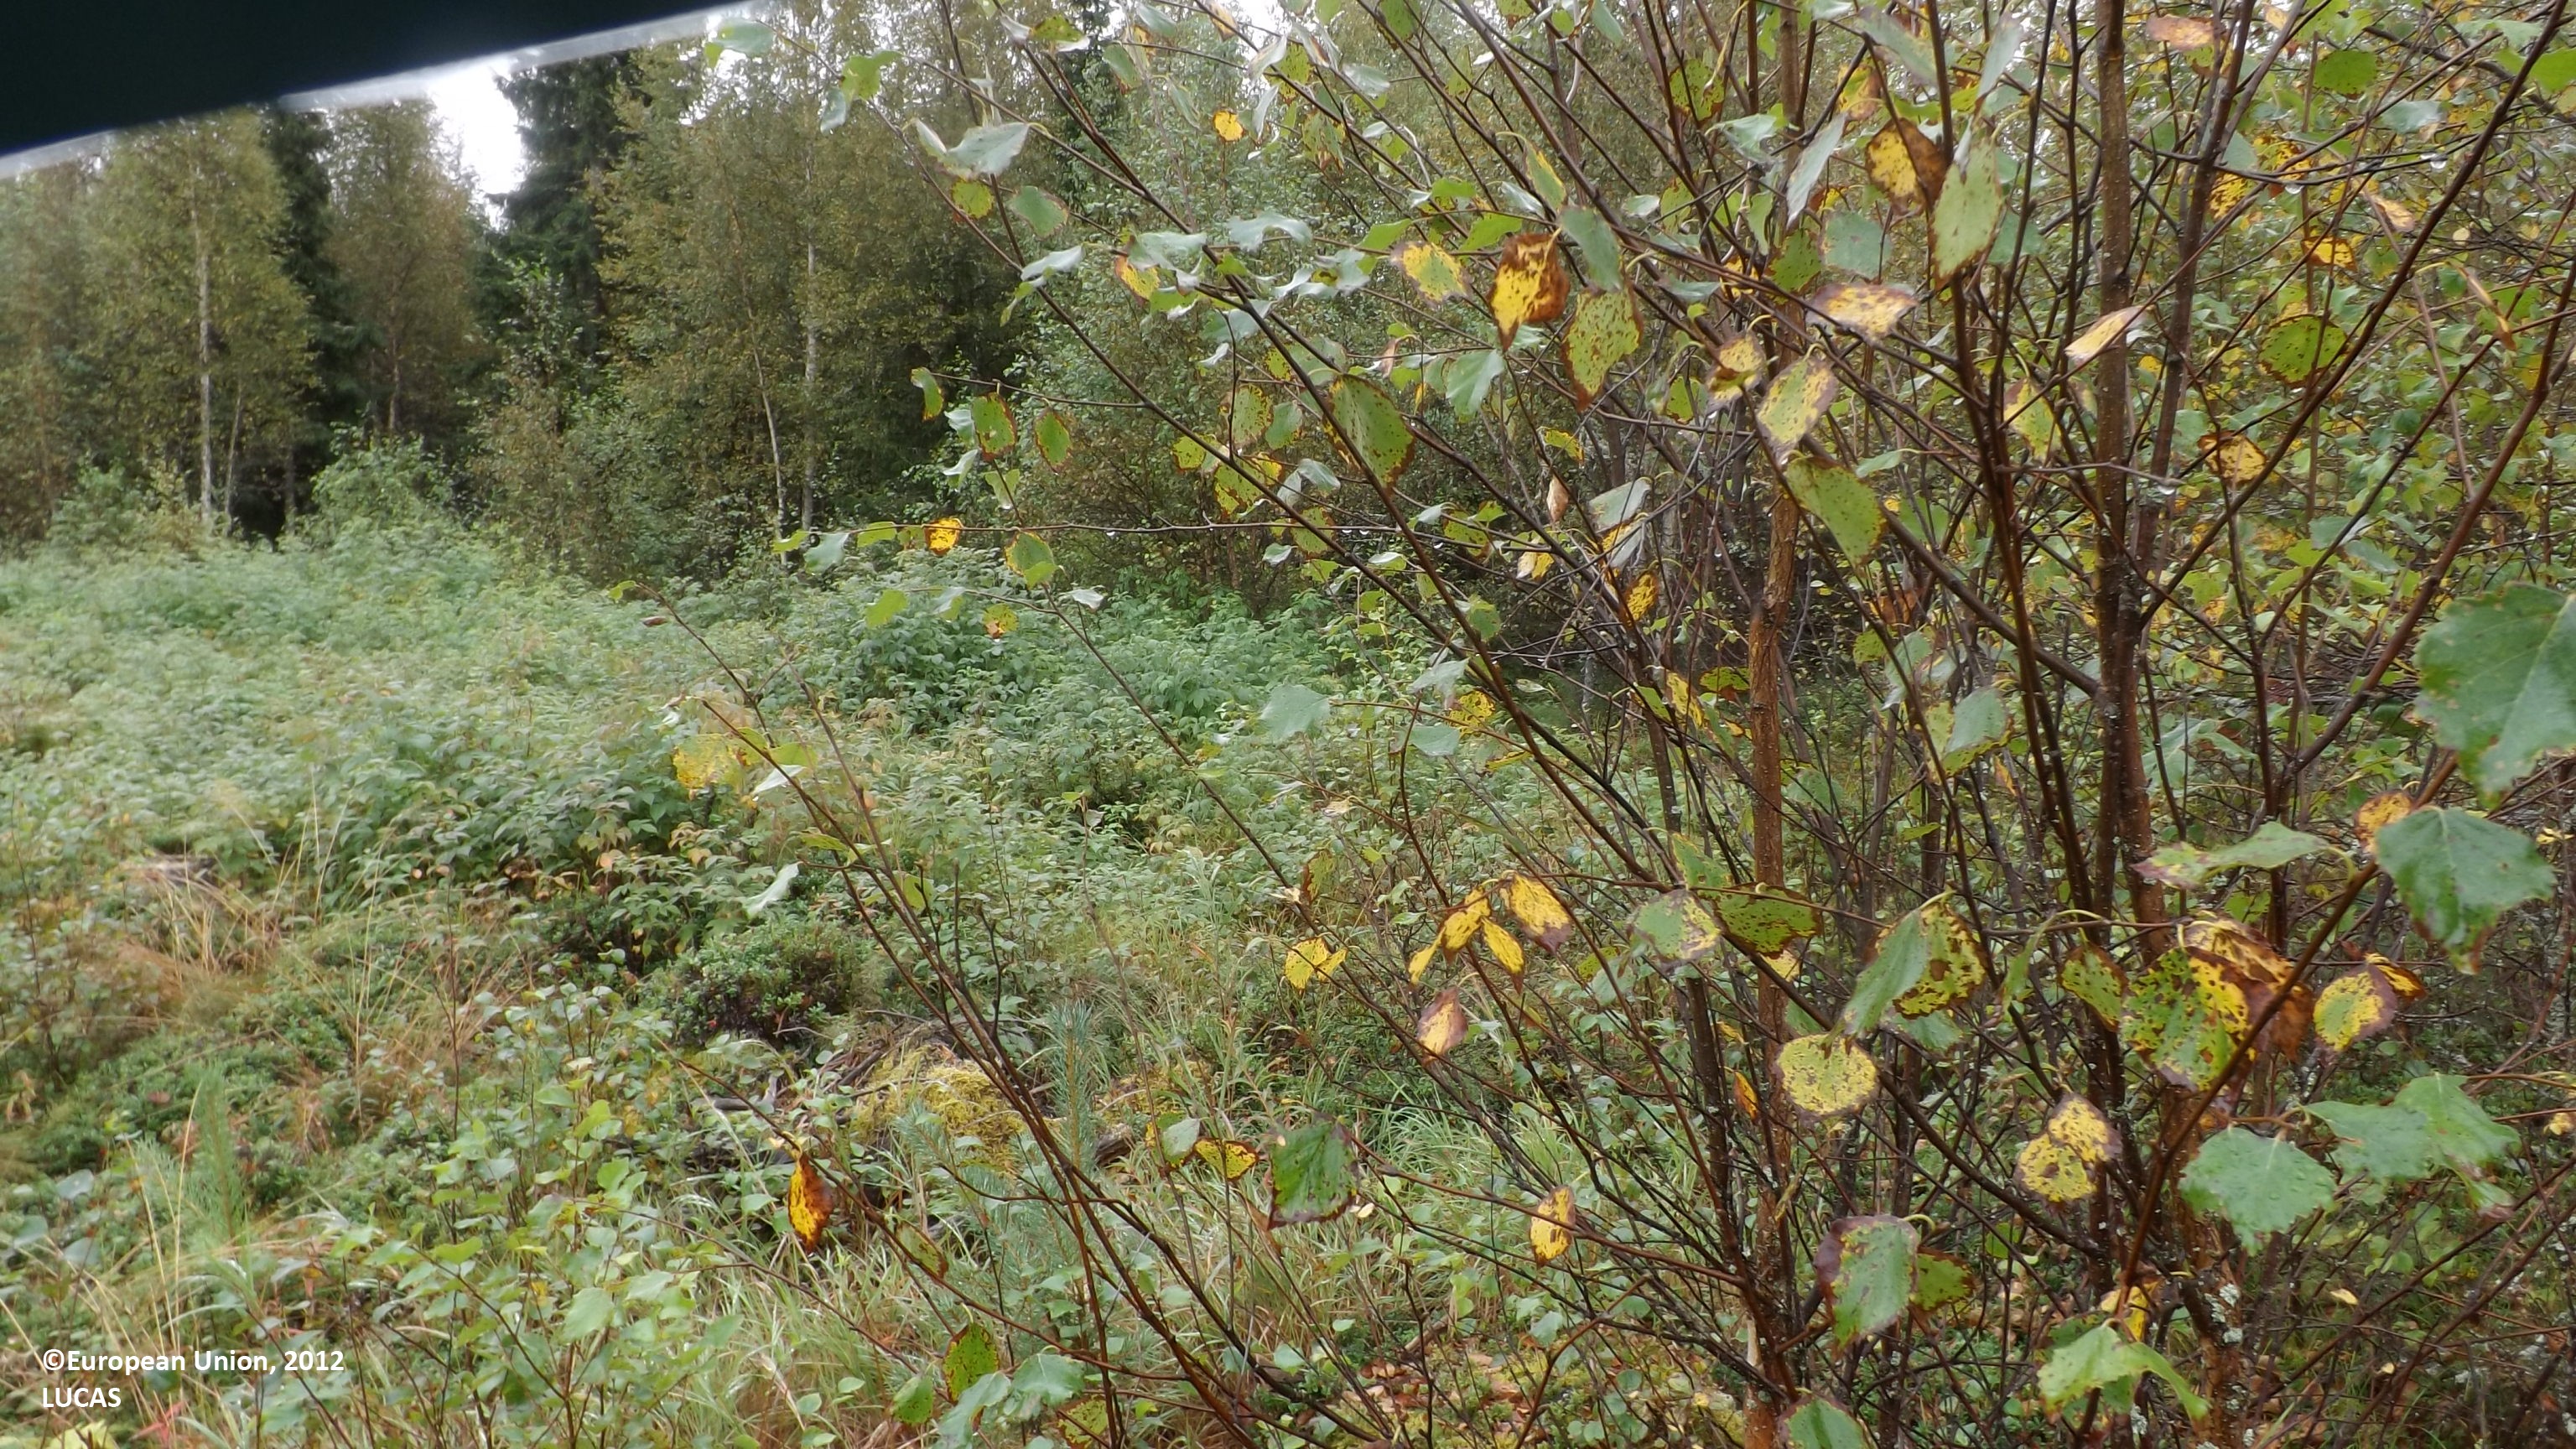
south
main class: Shrubland
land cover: Shrubland with sparse tree cover
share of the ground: 50 - 75 %
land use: Forestry
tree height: < 5 m
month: August
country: FI
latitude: 63.8053
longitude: 23.6452
